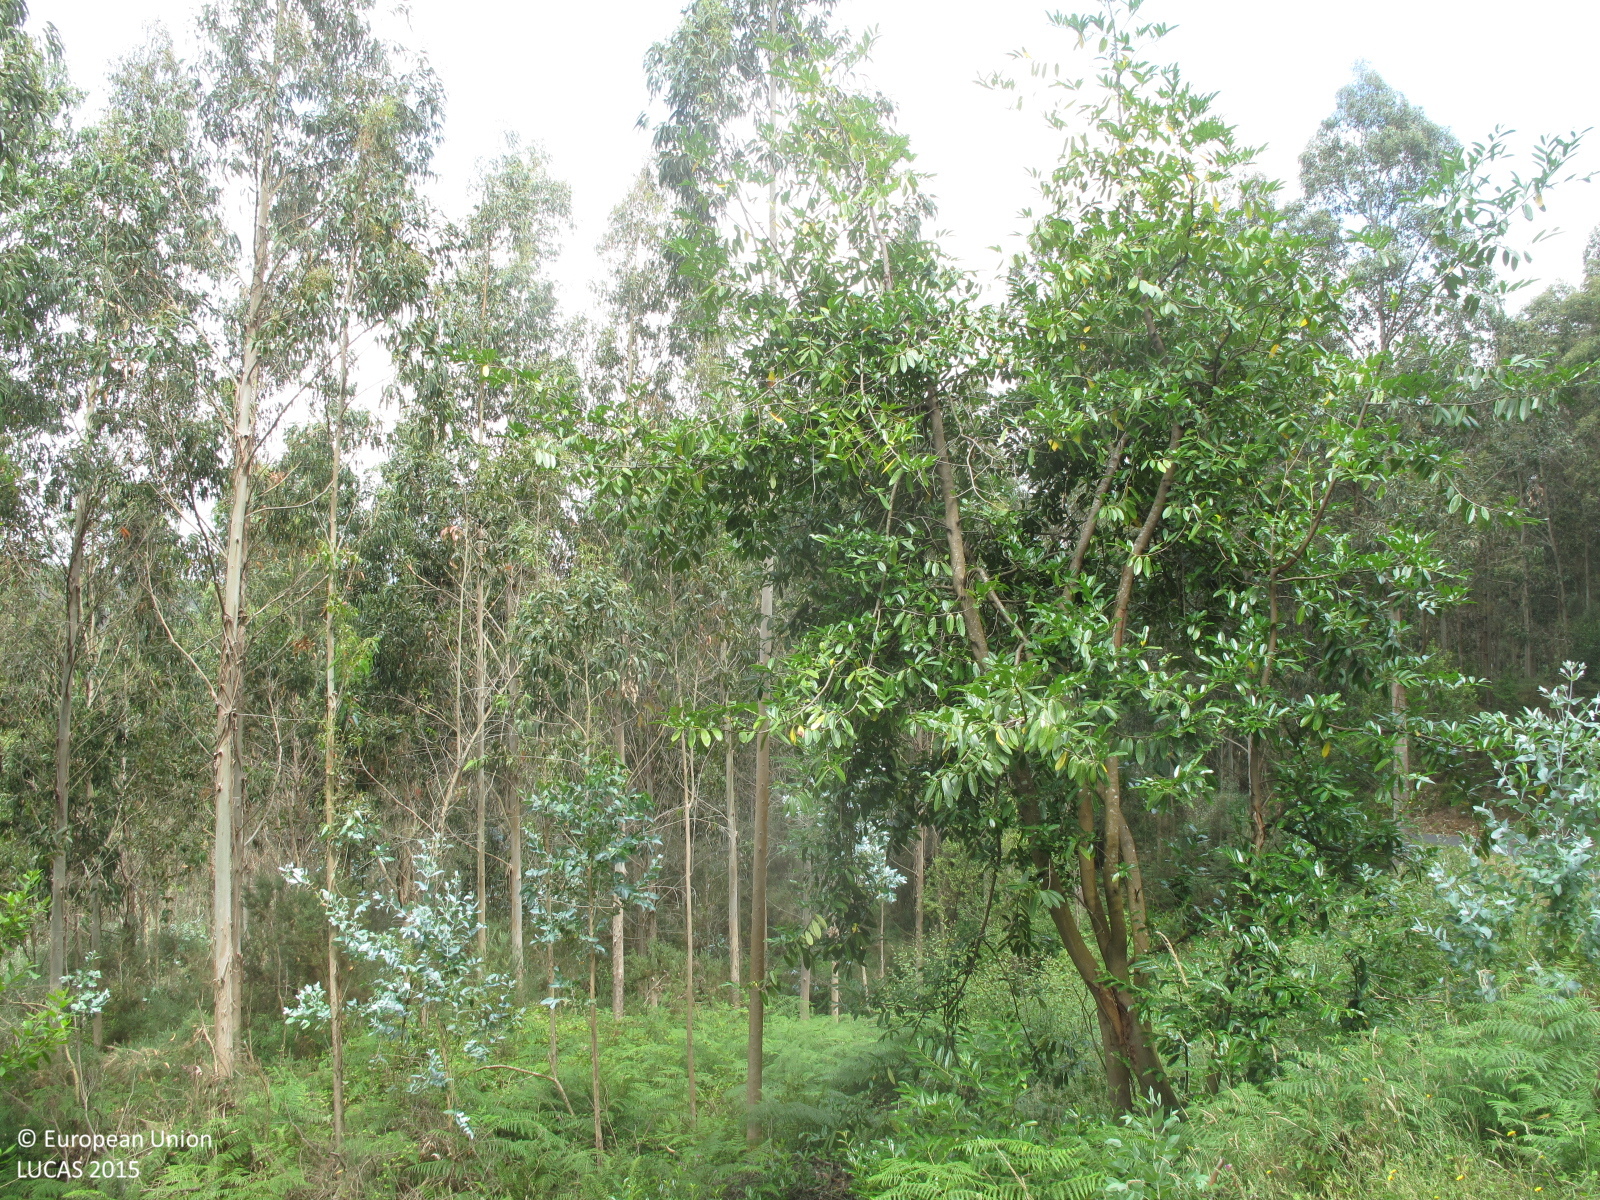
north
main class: Woodland
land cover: Broadleaved woodland
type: exotic forest
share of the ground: > 75 %
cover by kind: broadleaved forest trees 90 %, shrubs 10 %
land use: Forestry
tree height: > 5 m
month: July
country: ES
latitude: 43.4826
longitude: -8.0880
